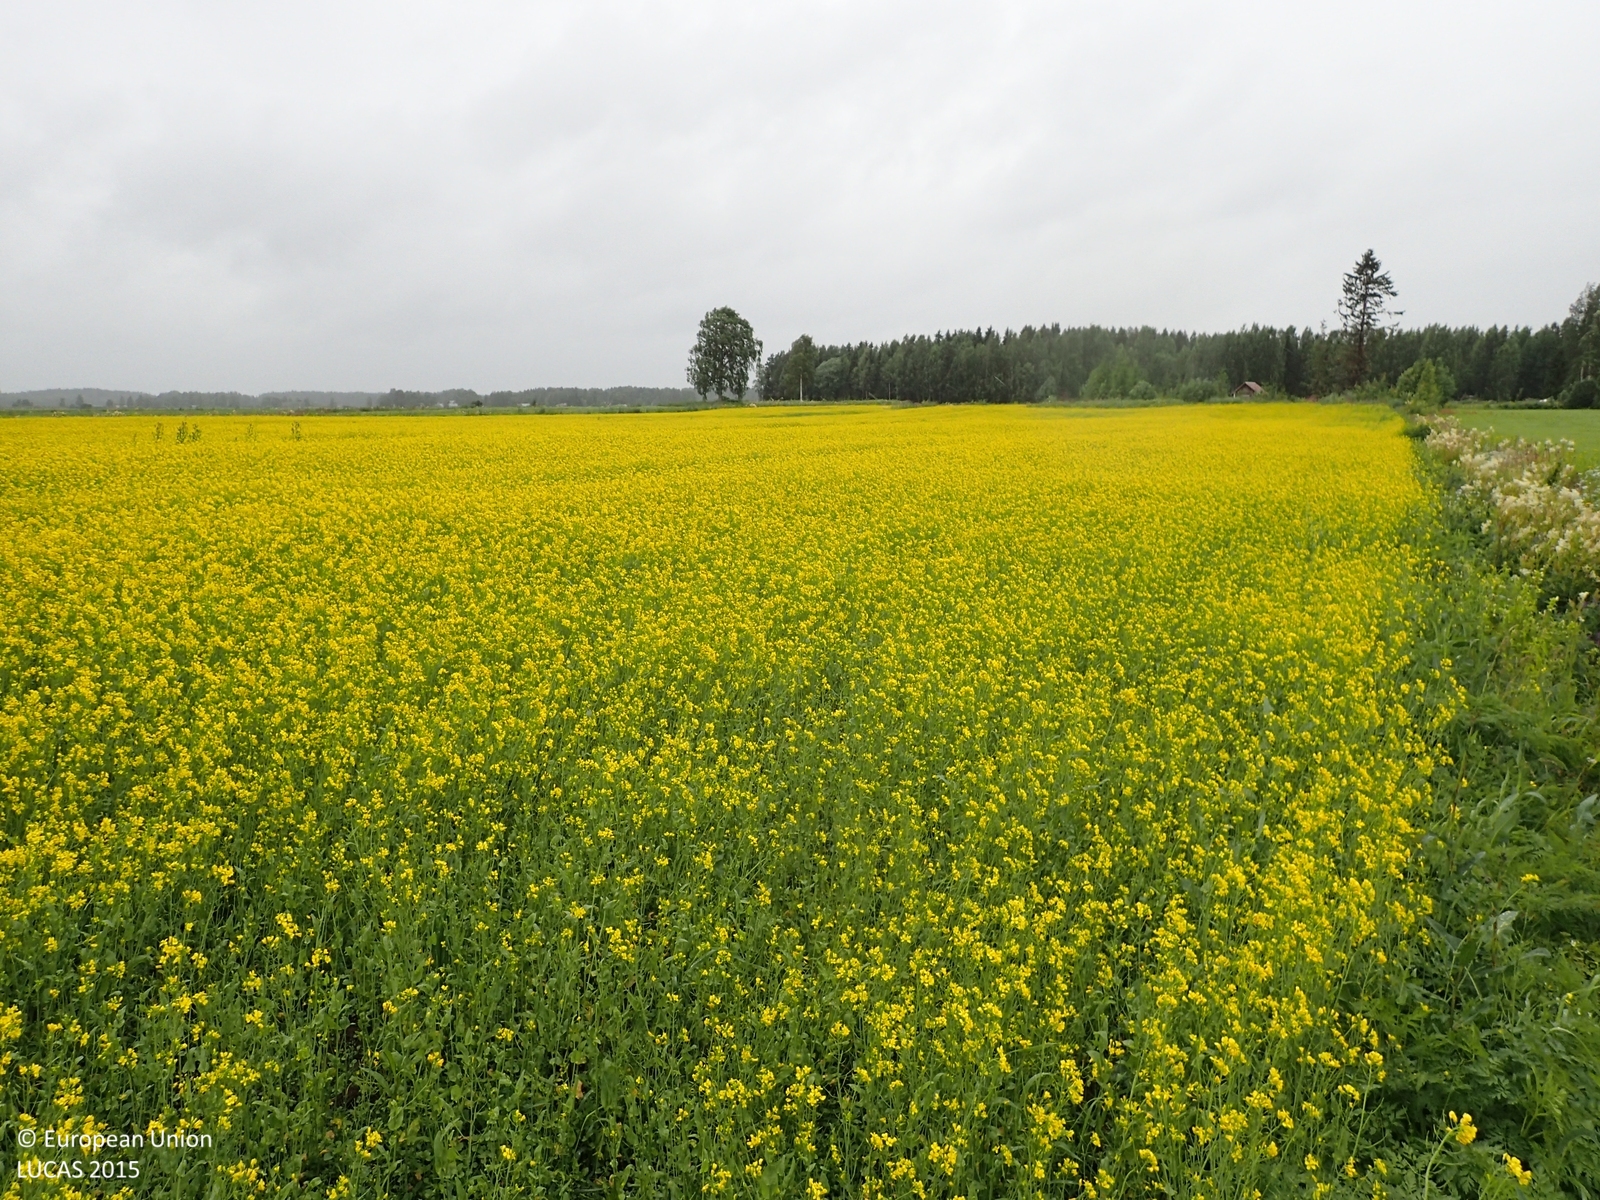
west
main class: Cropland
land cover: Rape and turnip rape
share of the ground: > 75 %
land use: Agriculture (excluding fallow land and kitchen gardens)
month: July
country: FI
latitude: 62.8537
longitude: 22.7671
